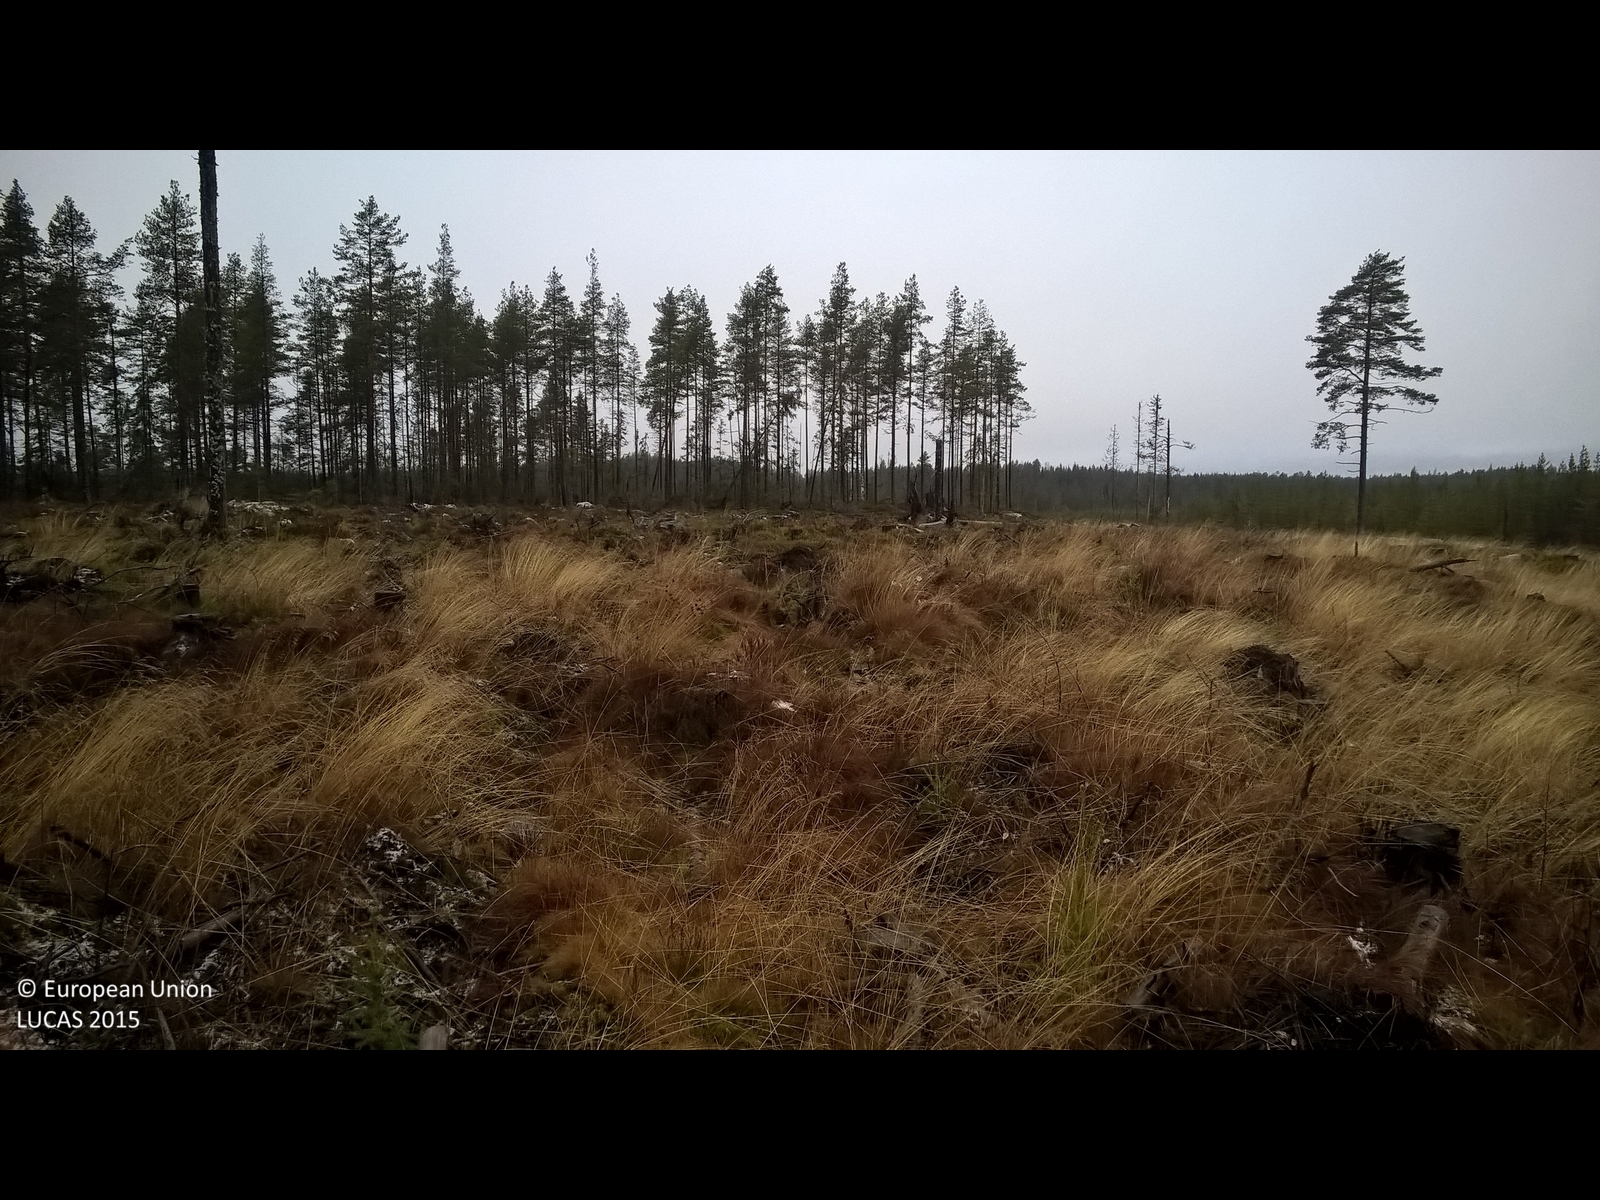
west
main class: Grassland
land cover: Grassland with sparse tree/shrub cover
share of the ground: > 75 %
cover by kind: herbaceous plants 75 %, shrubs 10 %, lichens and mosses 10 %, coniferous forest trees 5 %
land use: Forestry
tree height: < 5 m
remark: Clear cut
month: November
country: SE
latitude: 60.4404
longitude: 14.8400
